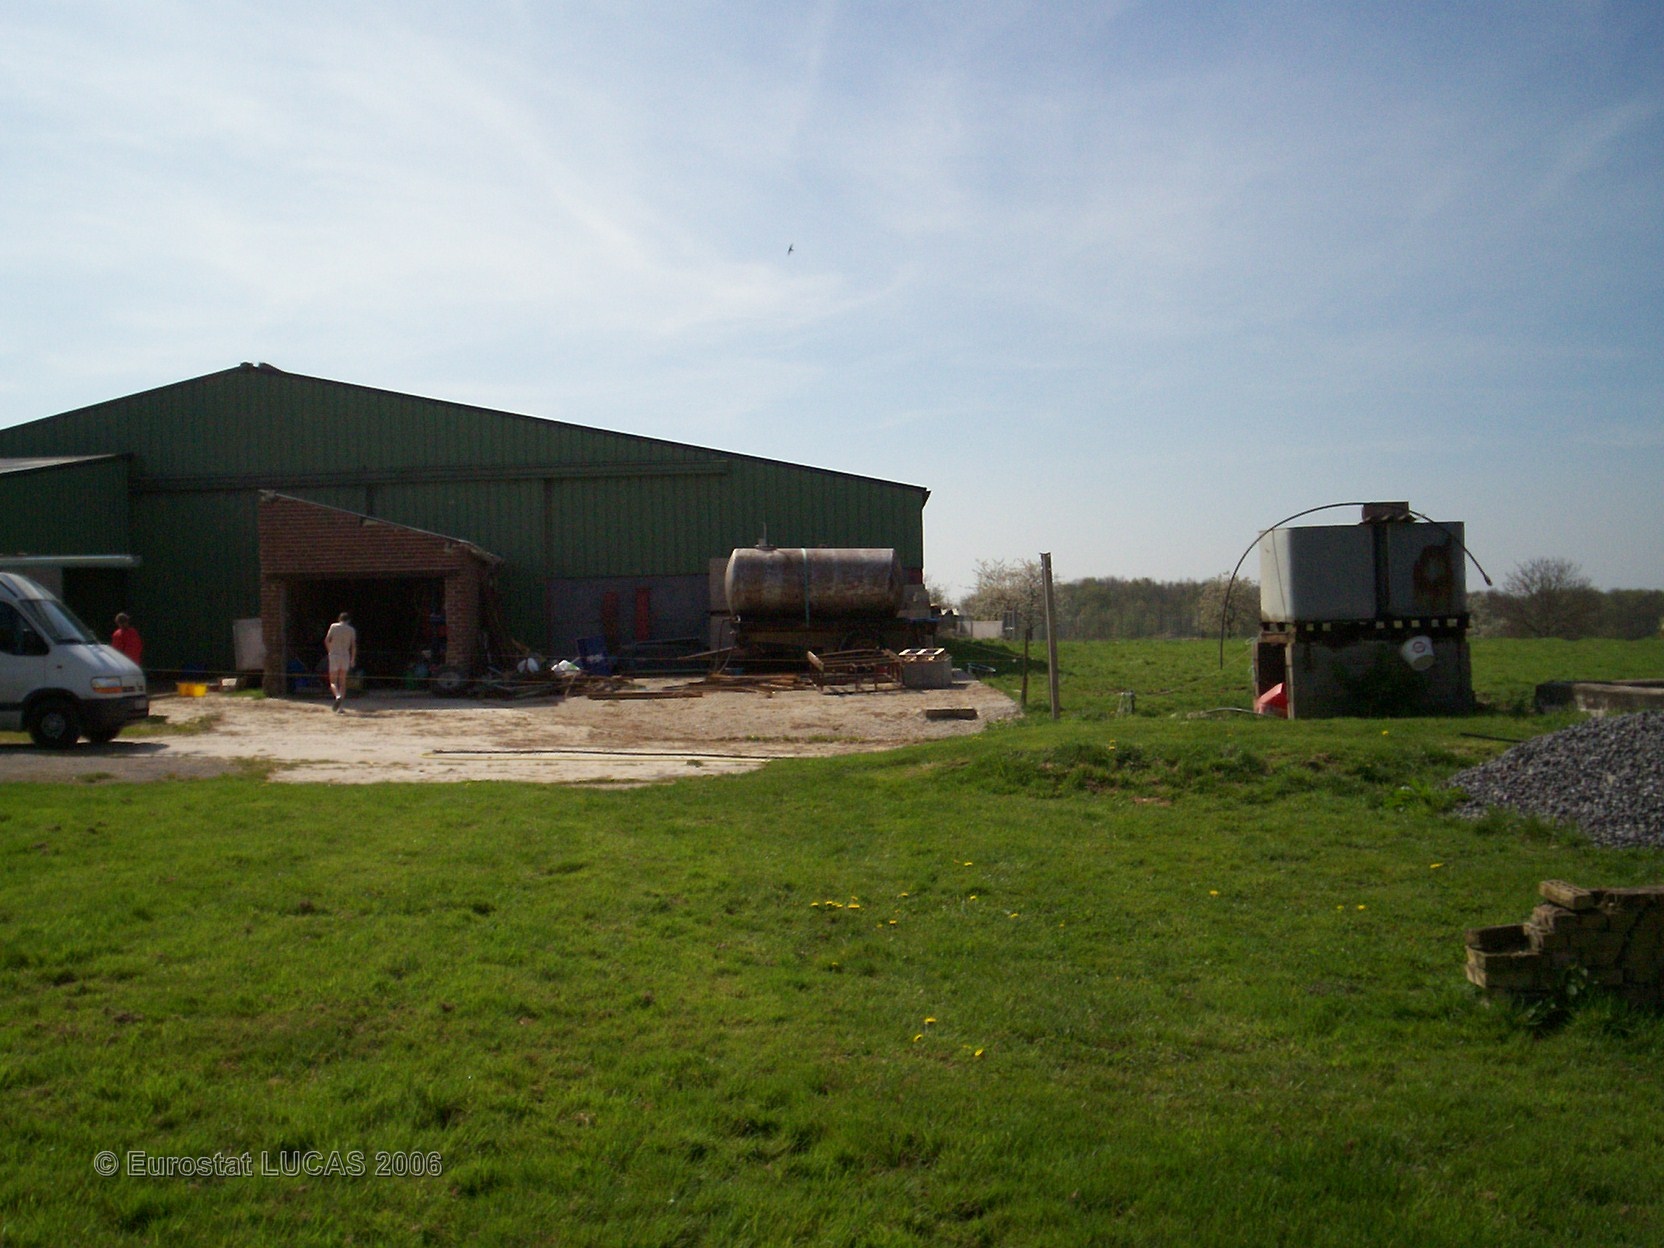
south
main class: Grassland
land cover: Grassland with sparse tree/shrub cover
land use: Residential
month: April
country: FR
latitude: 49.6328
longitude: 4.4162
